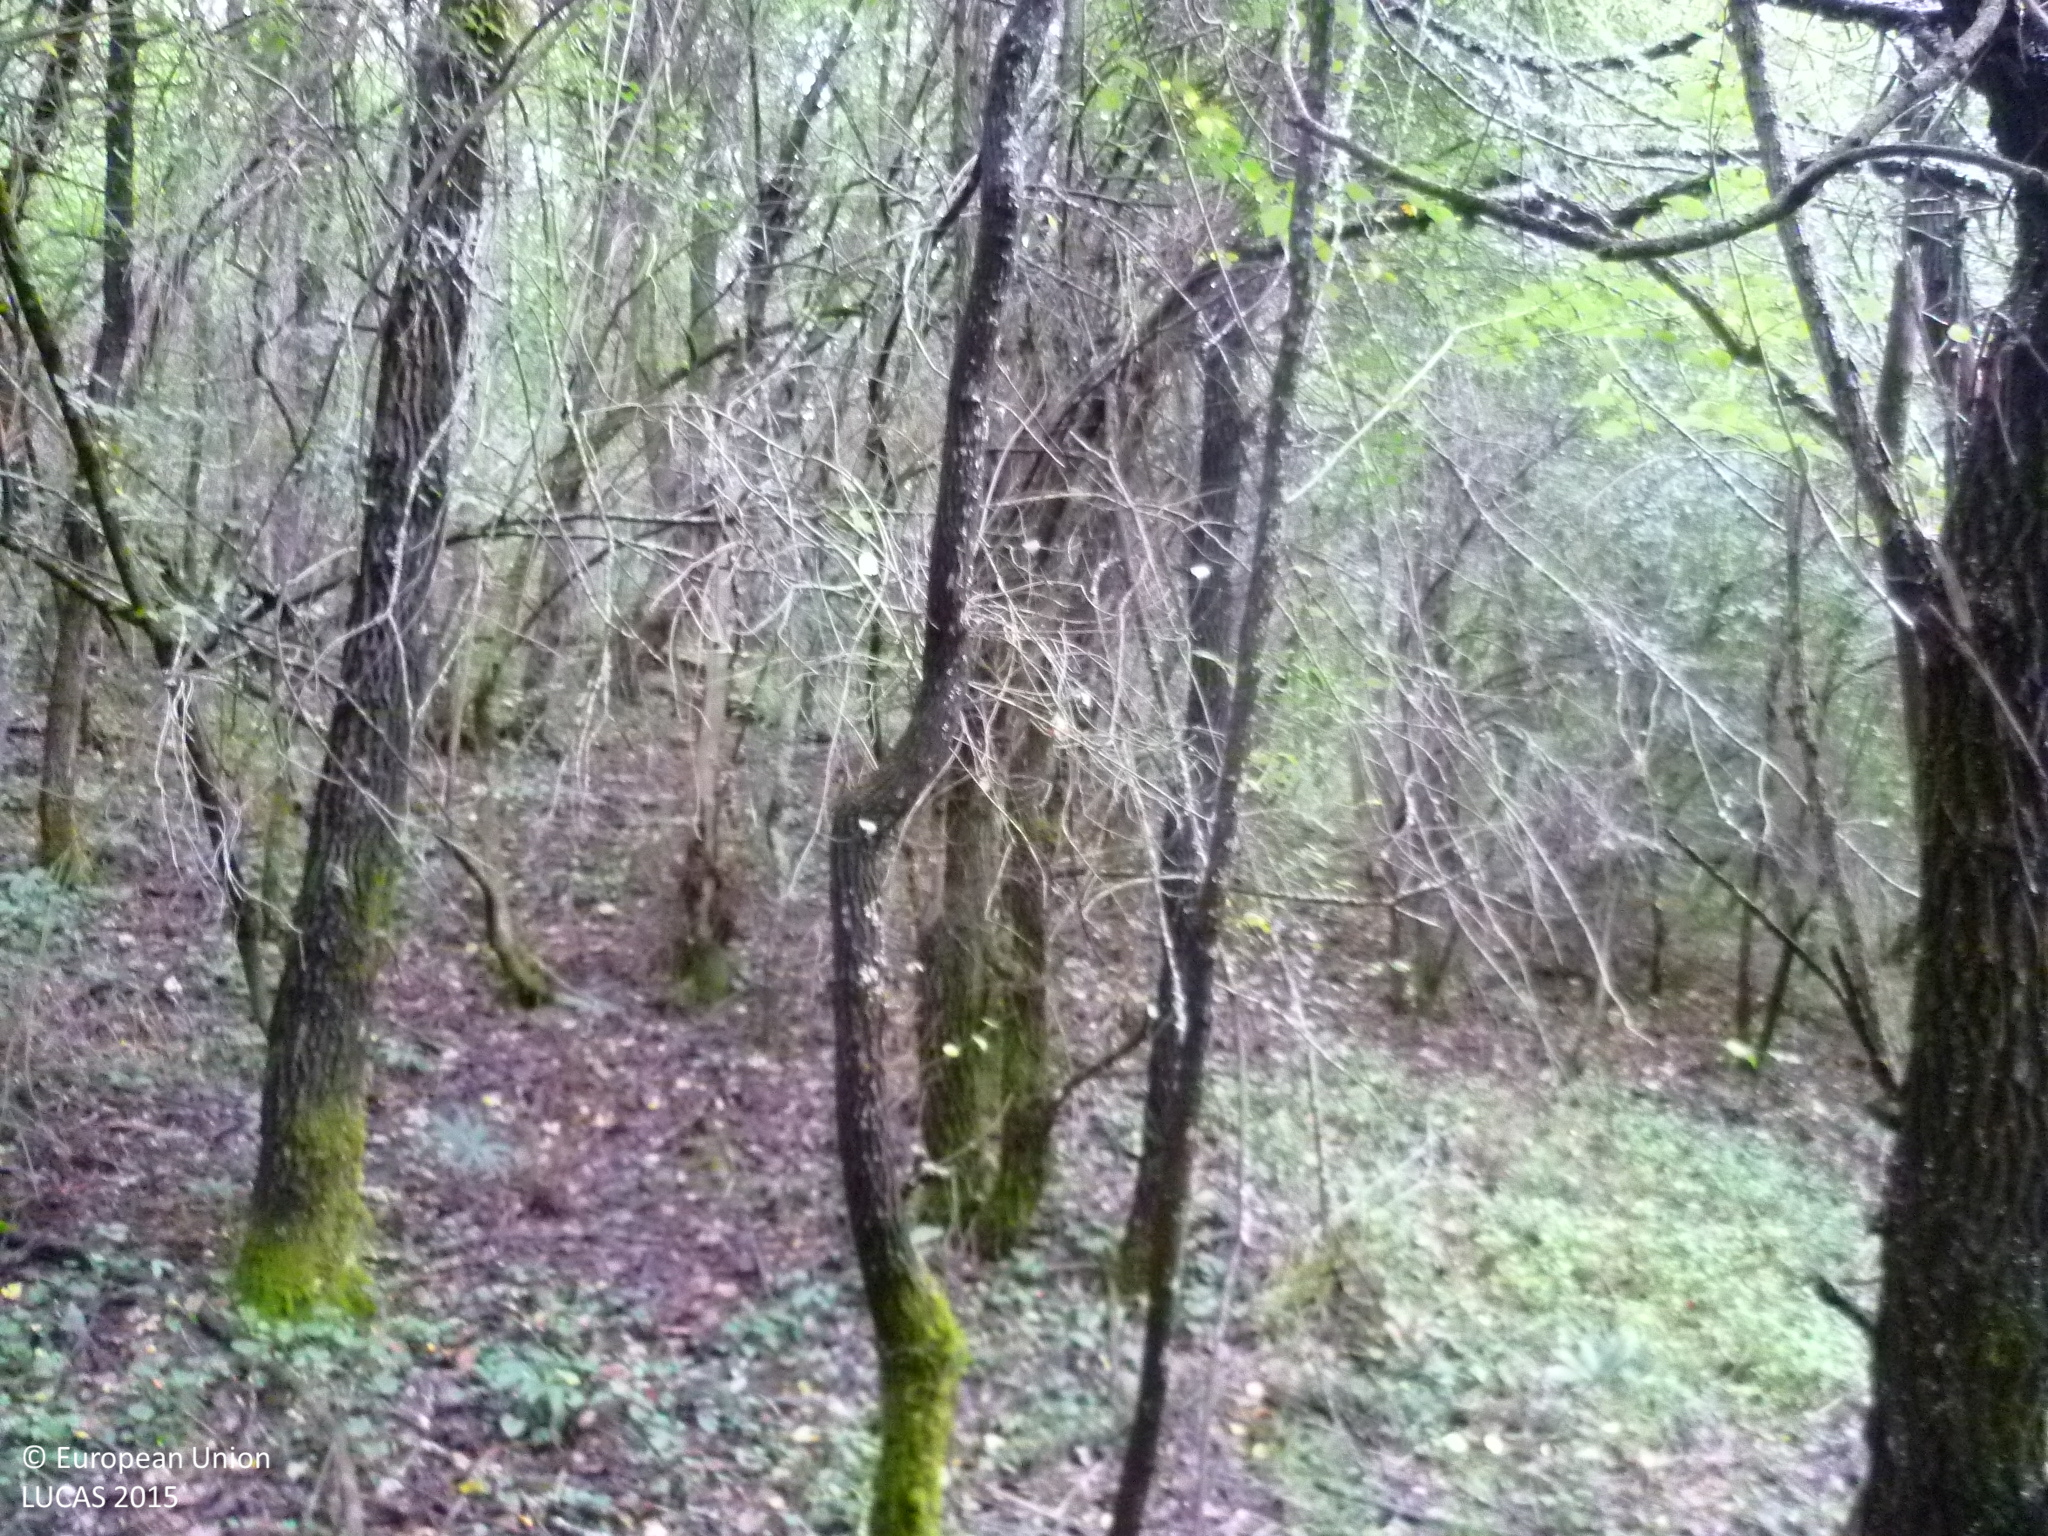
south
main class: Woodland
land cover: Broadleaved woodland
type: mesophytic deciduous forest
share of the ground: > 75 %
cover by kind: broadleaved forest trees 85 %, herbaceous plants 15 %
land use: Forestry
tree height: > 5 m
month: September
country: BG
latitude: 42.5950
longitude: 22.7363
